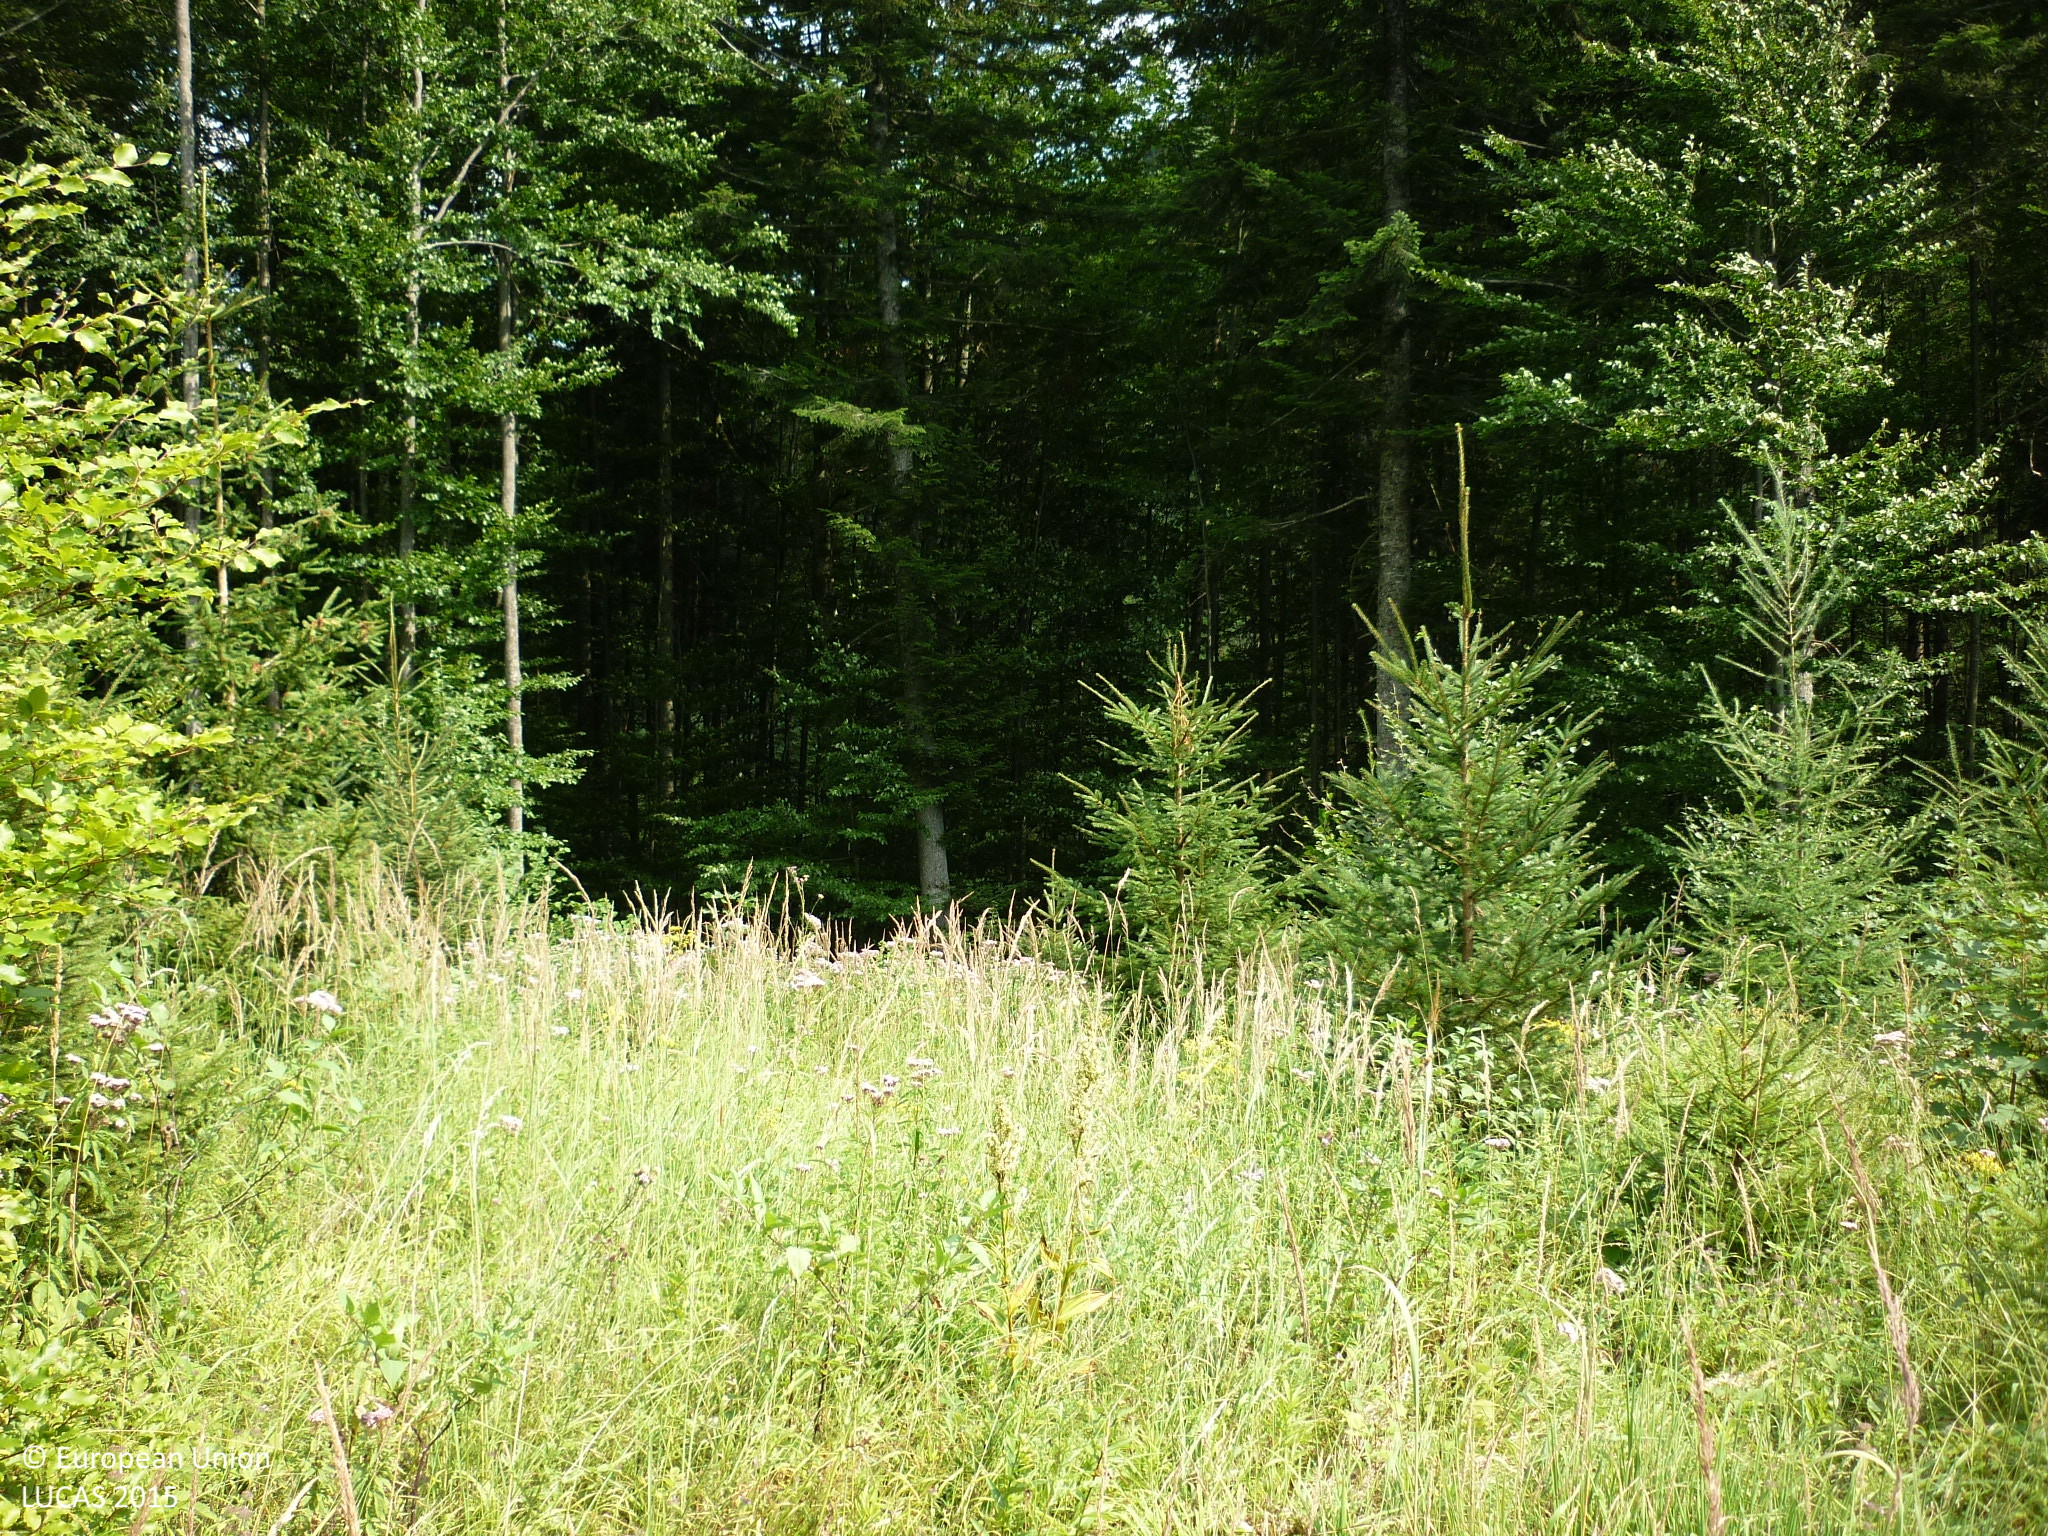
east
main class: Grassland
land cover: Grassland with sparse tree/shrub cover
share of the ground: > 75 %
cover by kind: herbaceous plants 95 %, coniferous forest trees 5 %
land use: Semi-natural and natural areas not in use
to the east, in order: Grassland with sparse tree/shrub cover; Spruce dominated mixed woodland; Spontaneously vegetated surfaces; Spruce dominated mixed woodland; Tracks; Spruce dominated mixed woodland; Grassland with sparse tree/shrub cover; Broadleaved woodland
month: August
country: AT
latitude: 47.6922
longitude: 14.2228
